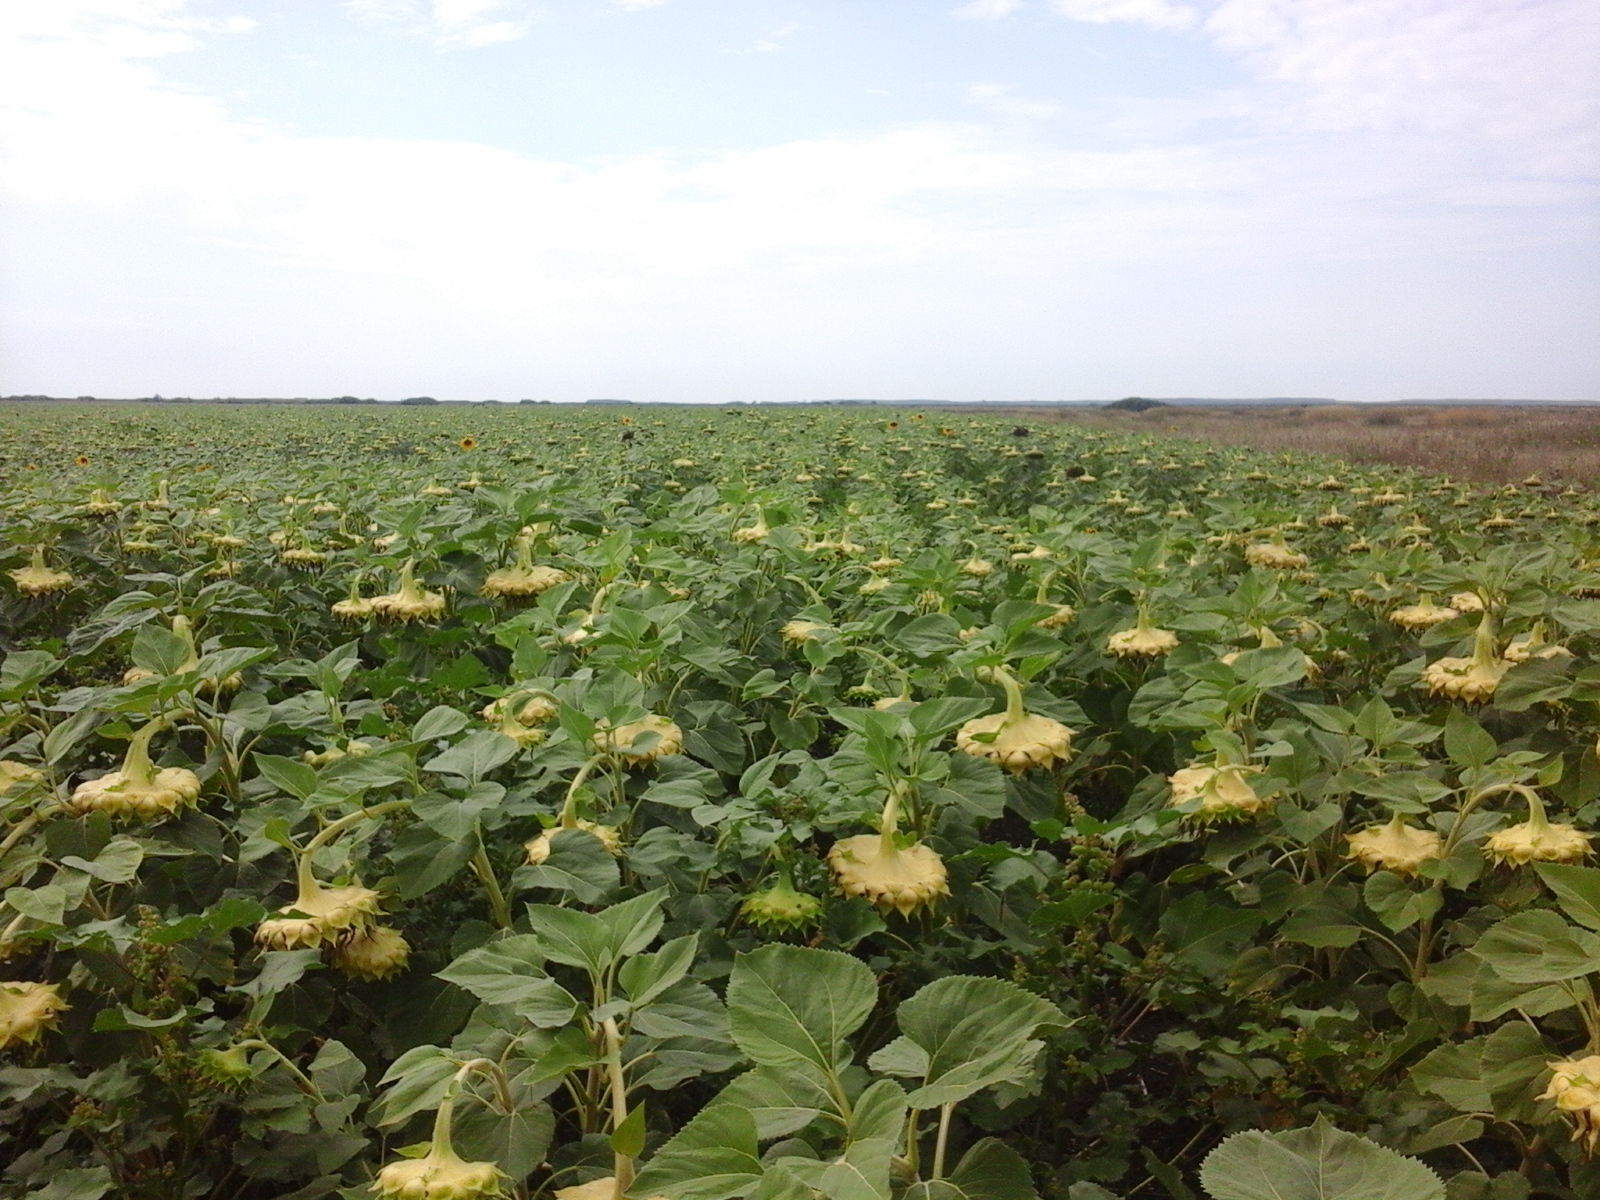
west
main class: Cropland
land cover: Sunflower
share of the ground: > 75 %
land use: Agriculture (excluding fallow land and kitchen gardens)
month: August
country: RO
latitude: 46.6207
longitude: 21.4912
